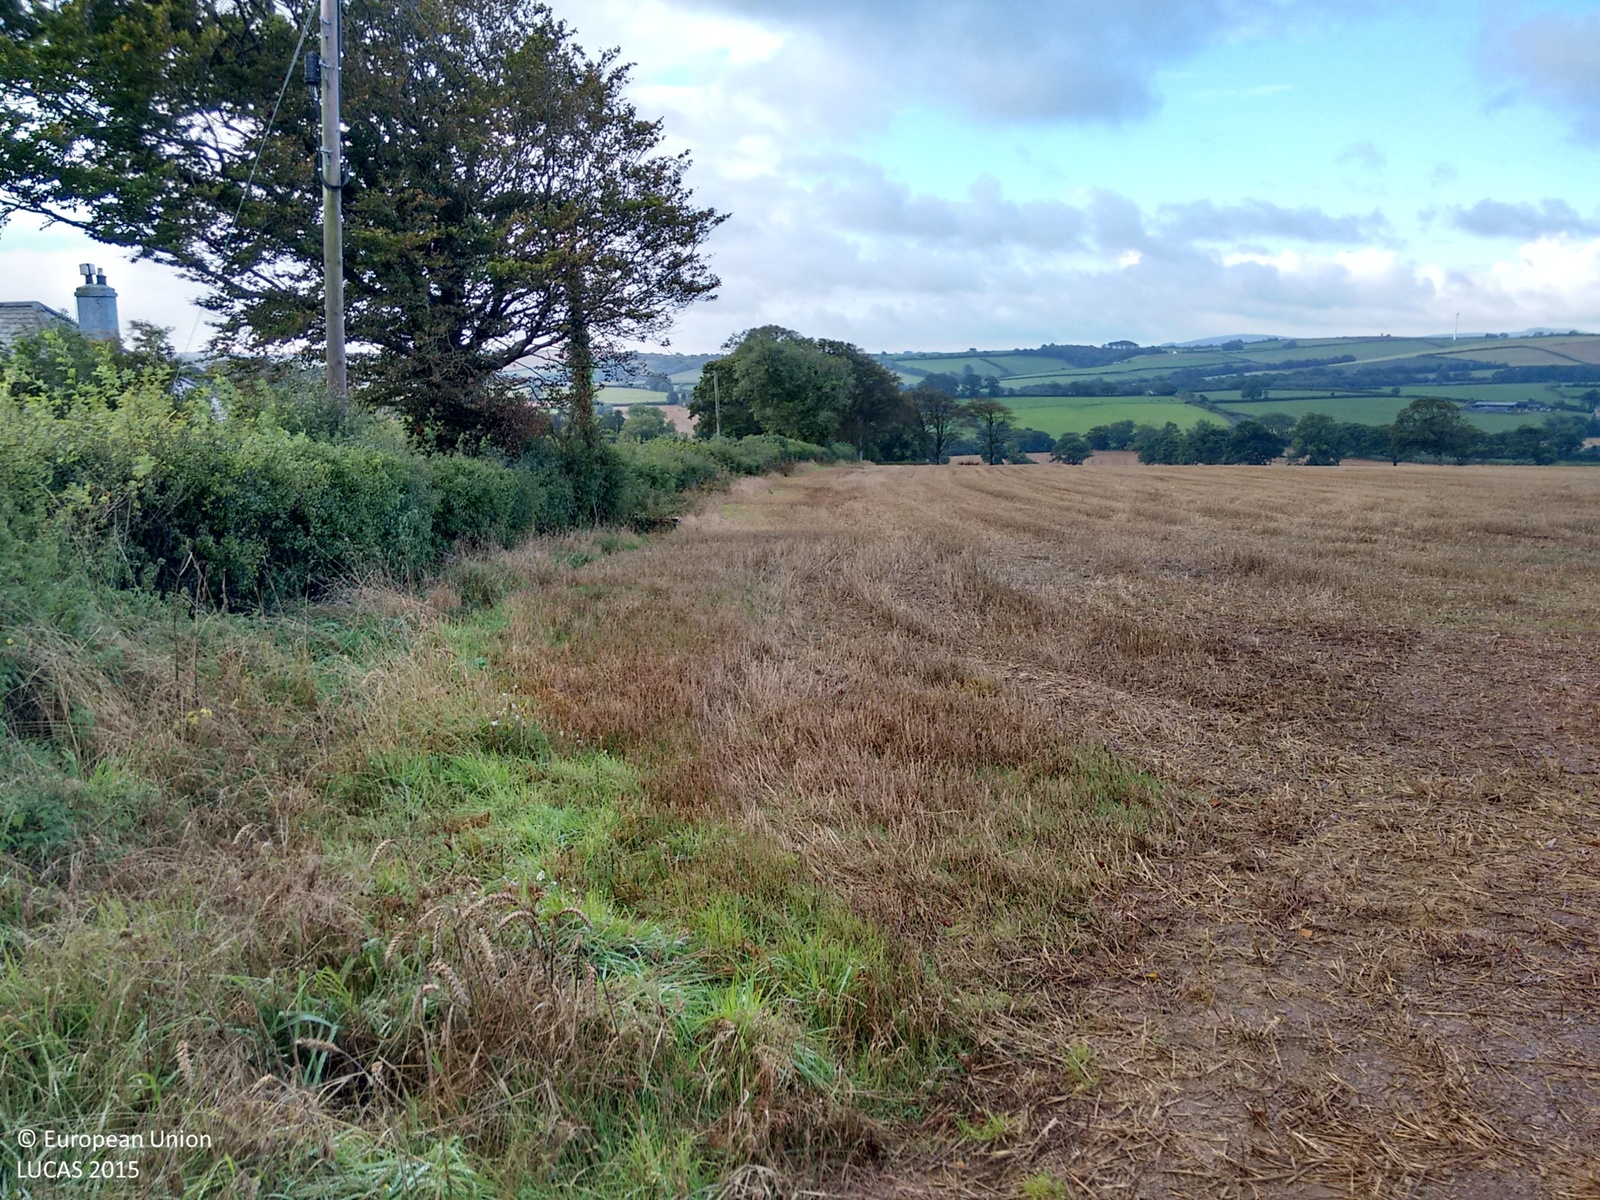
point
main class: Cropland
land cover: Common wheat
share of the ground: 25 - 50 %
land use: Agriculture (excluding fallow land and kitchen gardens)
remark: Harvested field
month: September
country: GB
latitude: 50.6031
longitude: -4.3578
